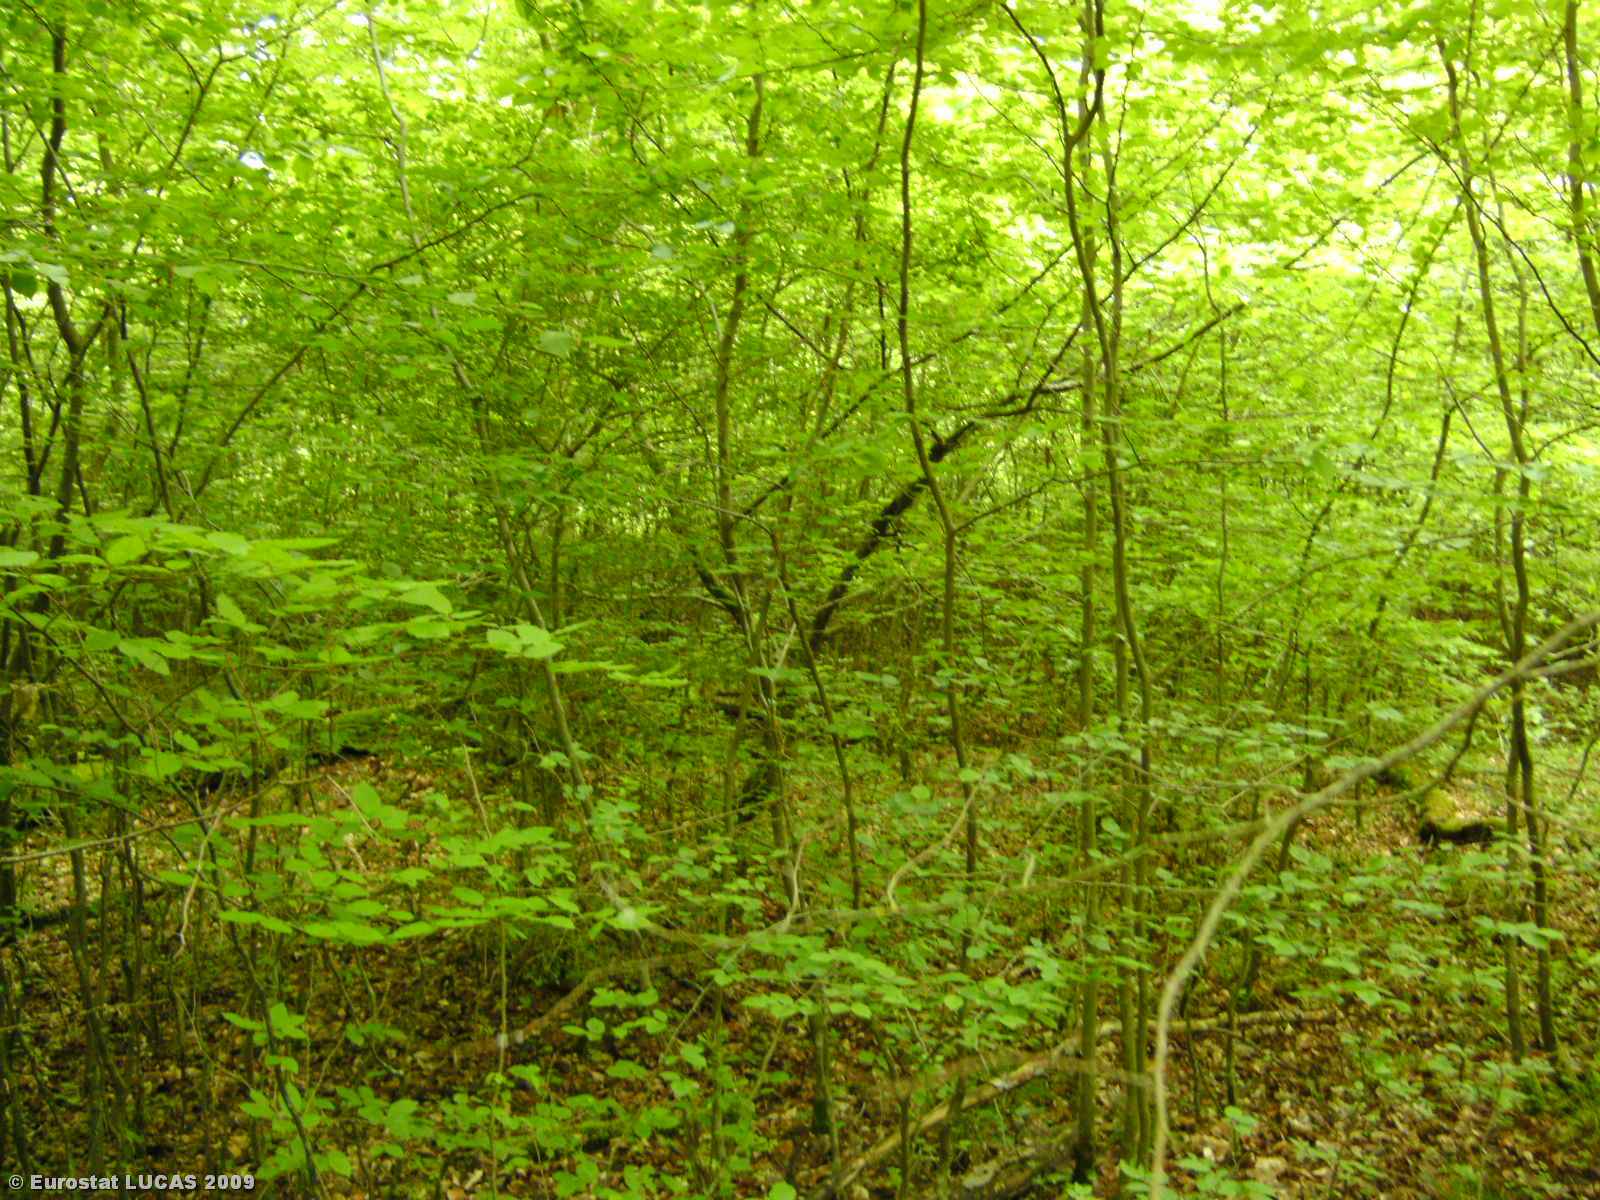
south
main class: Woodland
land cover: Broadleaved woodland
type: beech forest
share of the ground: > 75 %
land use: Forestry
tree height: > 5 m
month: May
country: LU
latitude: 49.6912
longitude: 6.2706
